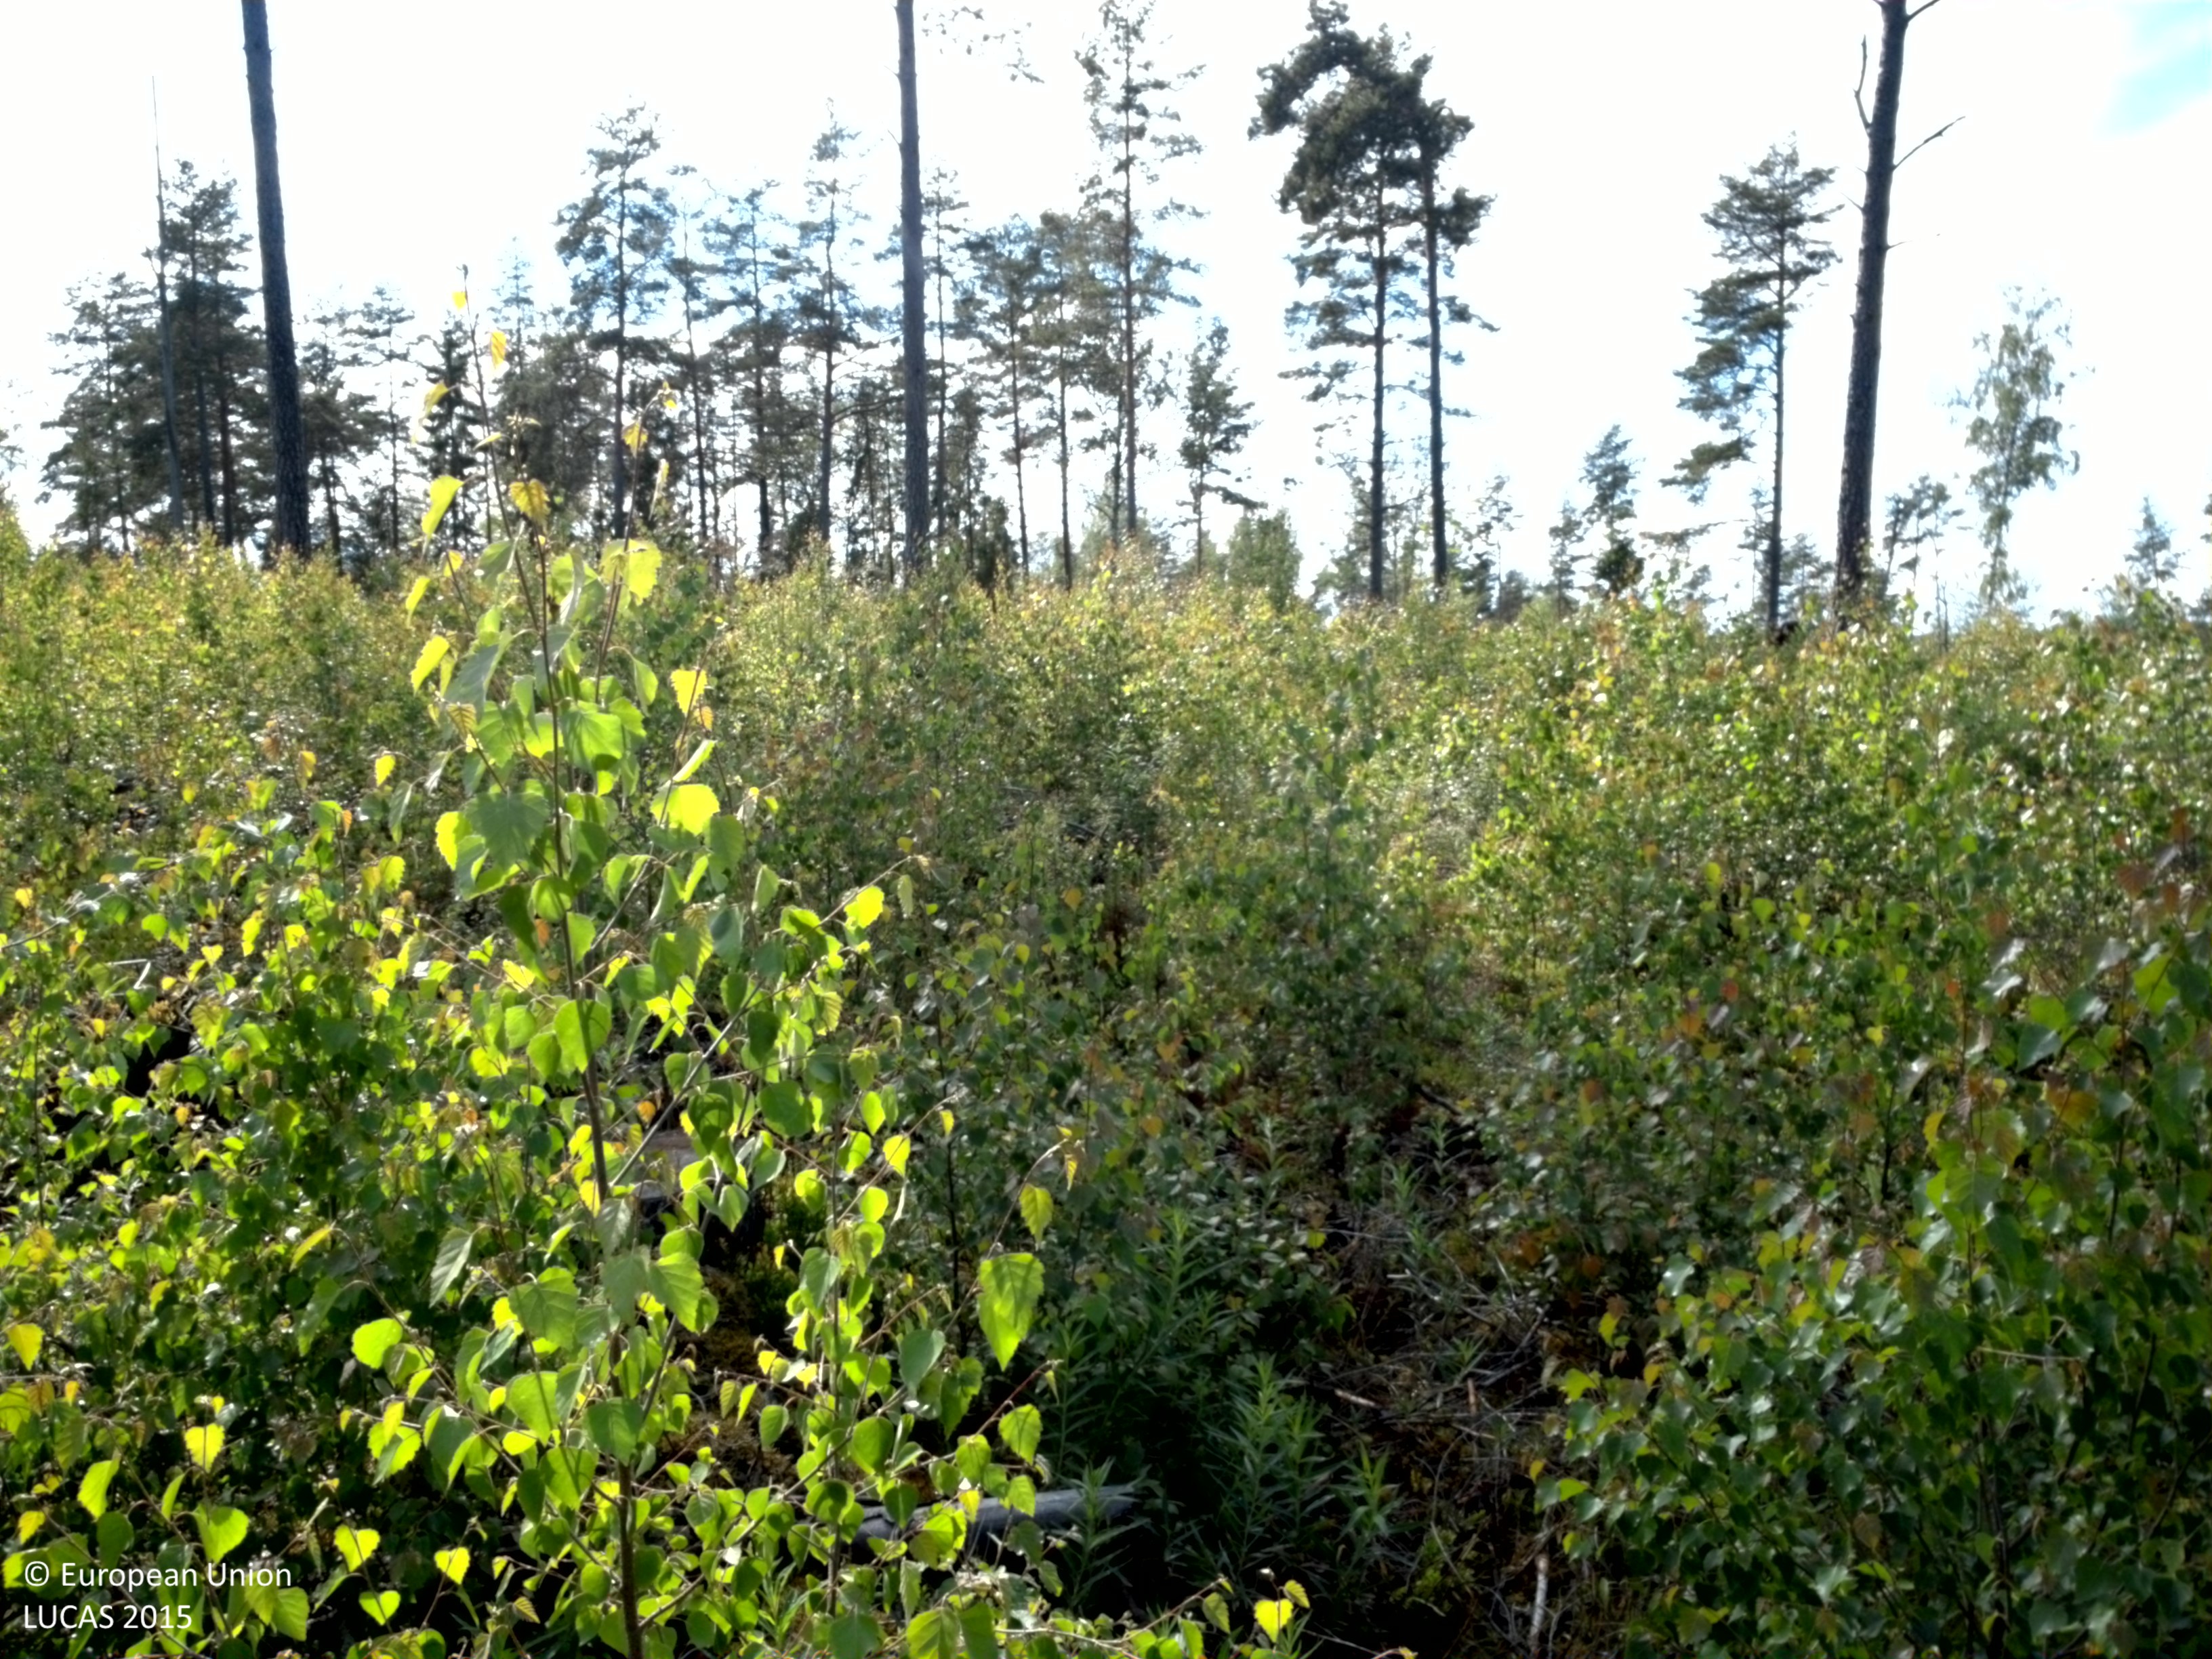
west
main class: Woodland
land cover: Broadleaved woodland
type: boreal forest
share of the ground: 10 - 25 %
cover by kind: lichens and mosses 55 %, broadleaved forest trees 20 %, herbaceous plants 20 %, coniferous forest trees 5 %
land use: Forestry
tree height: < 5 m
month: June
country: SE
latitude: 59.8957
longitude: 17.0525
